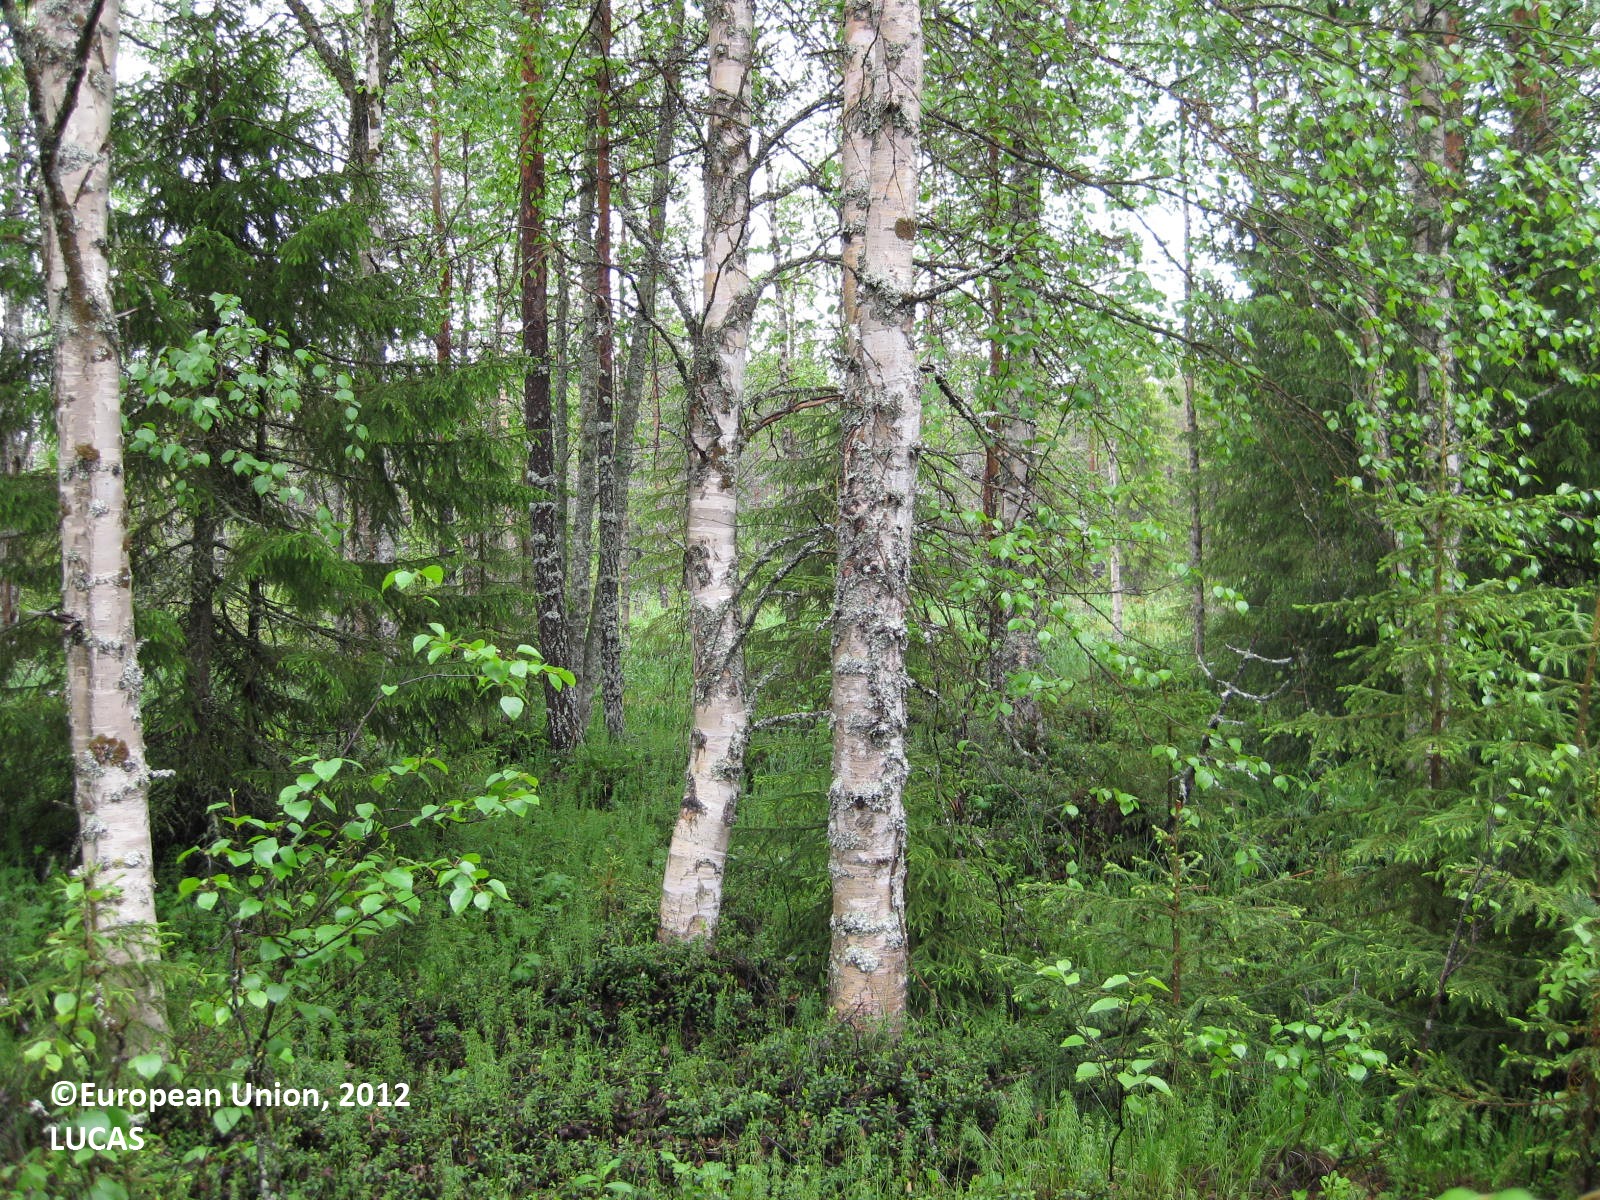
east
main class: Woodland
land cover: Other mixed woodland
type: boreal forest
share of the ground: > 75 %
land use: Forestry
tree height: > 5 m
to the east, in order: Other mixed woodland; Rivers and streams; Other mixed woodland; Ditches and canals; Pine dominated coniferous woodland; Ditches and canals; Pine dominated coniferous woodland; Pine dominated mixed woodland; Ditches and canals; Pine dominated coniferous woodland; Tracks; Pine dominated coniferous woodland; Ditches and canals; Pine dominated coniferous woodland; Ditches and canals; Other coniferous woodland; Shrubland with sparse tree cover; Tracks; Shrubland with sparse tree cover; Ditches and canals; Shrubland with sparse tree cover
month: June
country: FI
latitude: 65.0837
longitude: 29.0129
